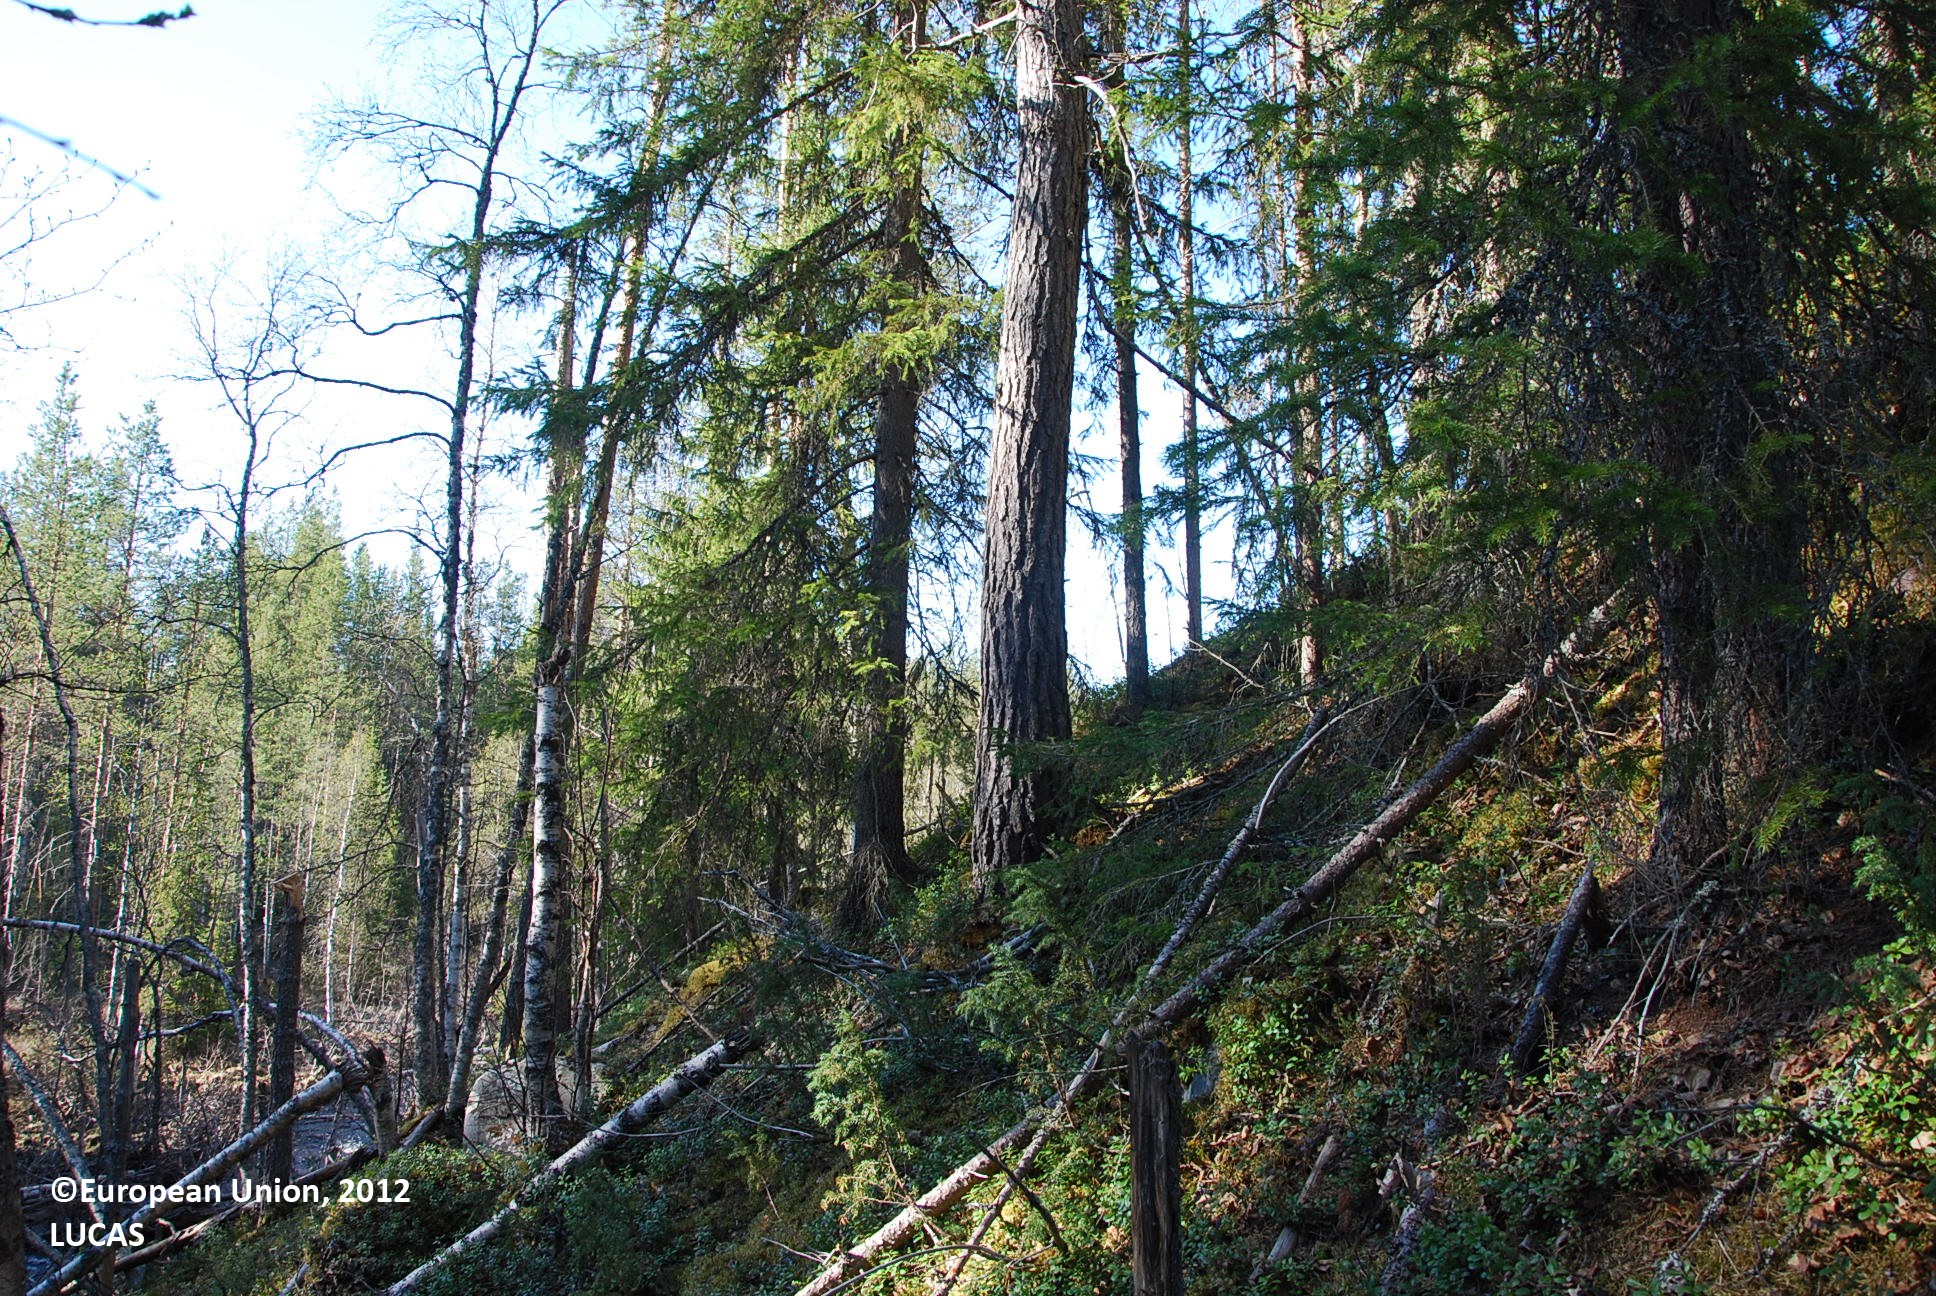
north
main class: Woodland
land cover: Pine dominated mixed woodland
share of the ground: > 75 %
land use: Forestry
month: May
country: FI
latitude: 66.7426
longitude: 28.7841
